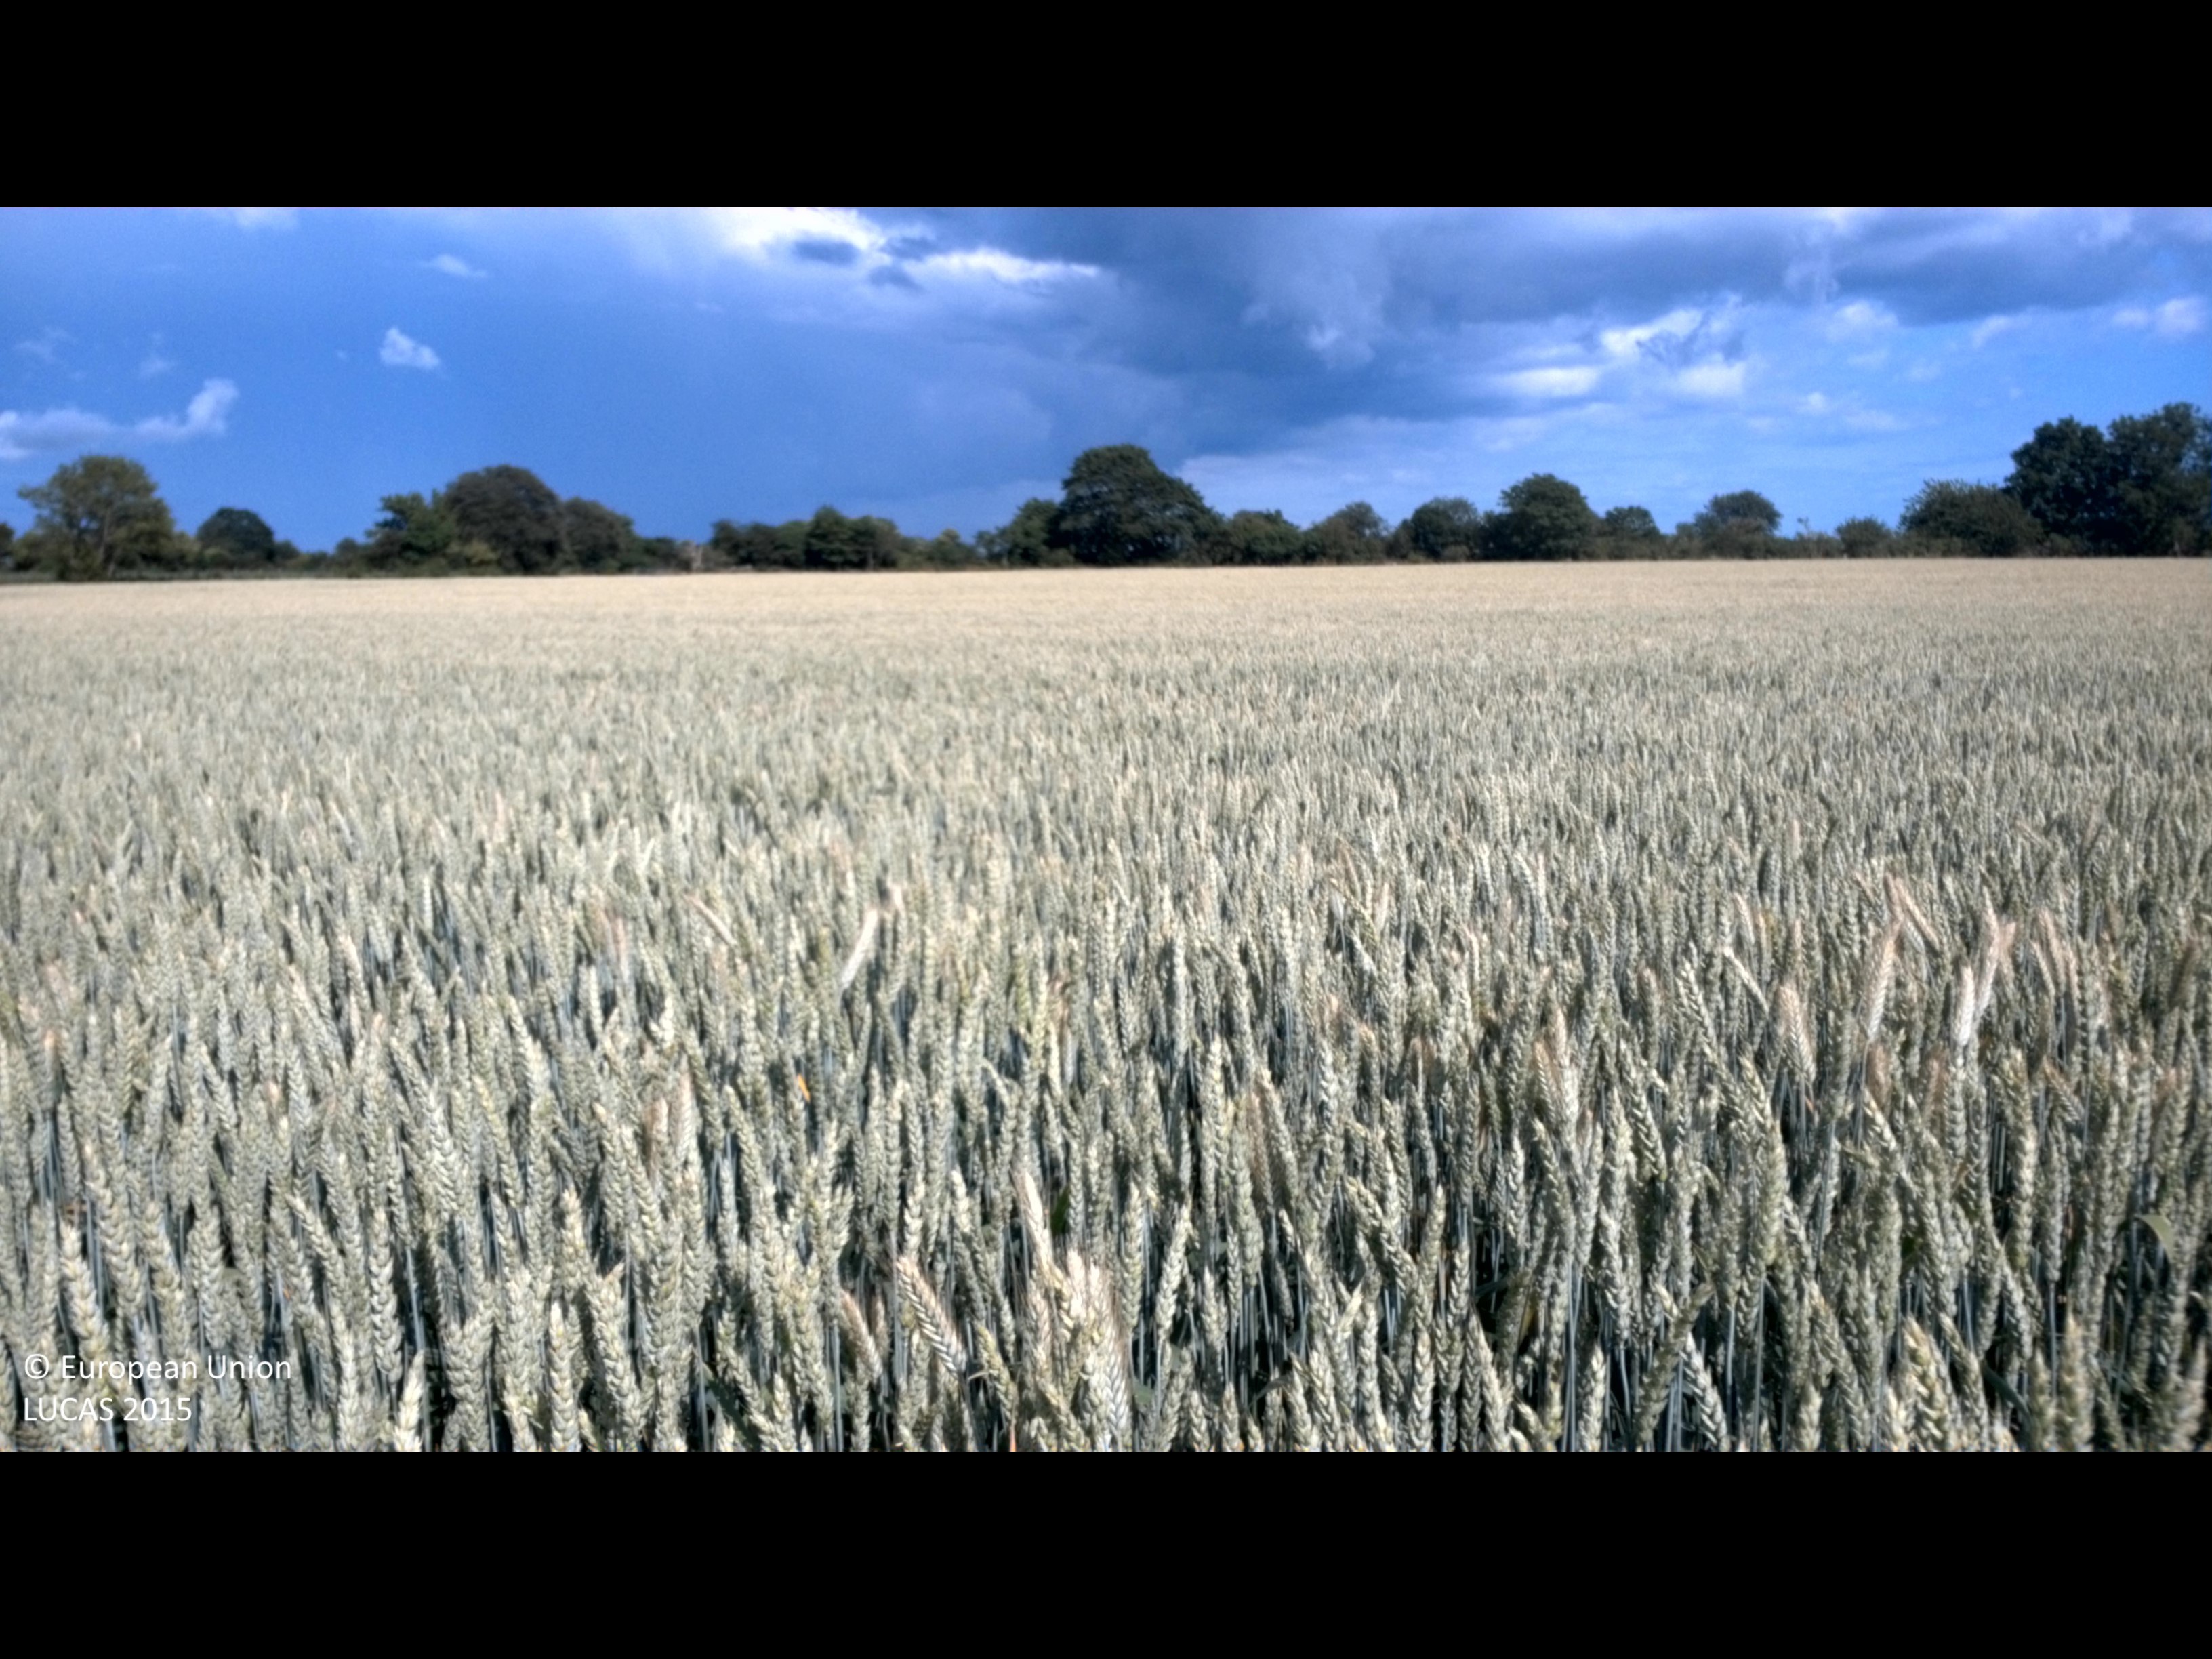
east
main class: Cropland
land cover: Common wheat
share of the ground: > 75 %
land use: Agriculture (excluding fallow land and kitchen gardens)
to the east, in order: Common wheat; Fences; Broadleaved woodland; Dry stone walls; Shrubland without tree cover; Grassland without tree/shrub cover; Shruby margins; Dry stone walls; Grassland without tree/shrub cover
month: July
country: SE
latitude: 56.5841
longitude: 16.4652
